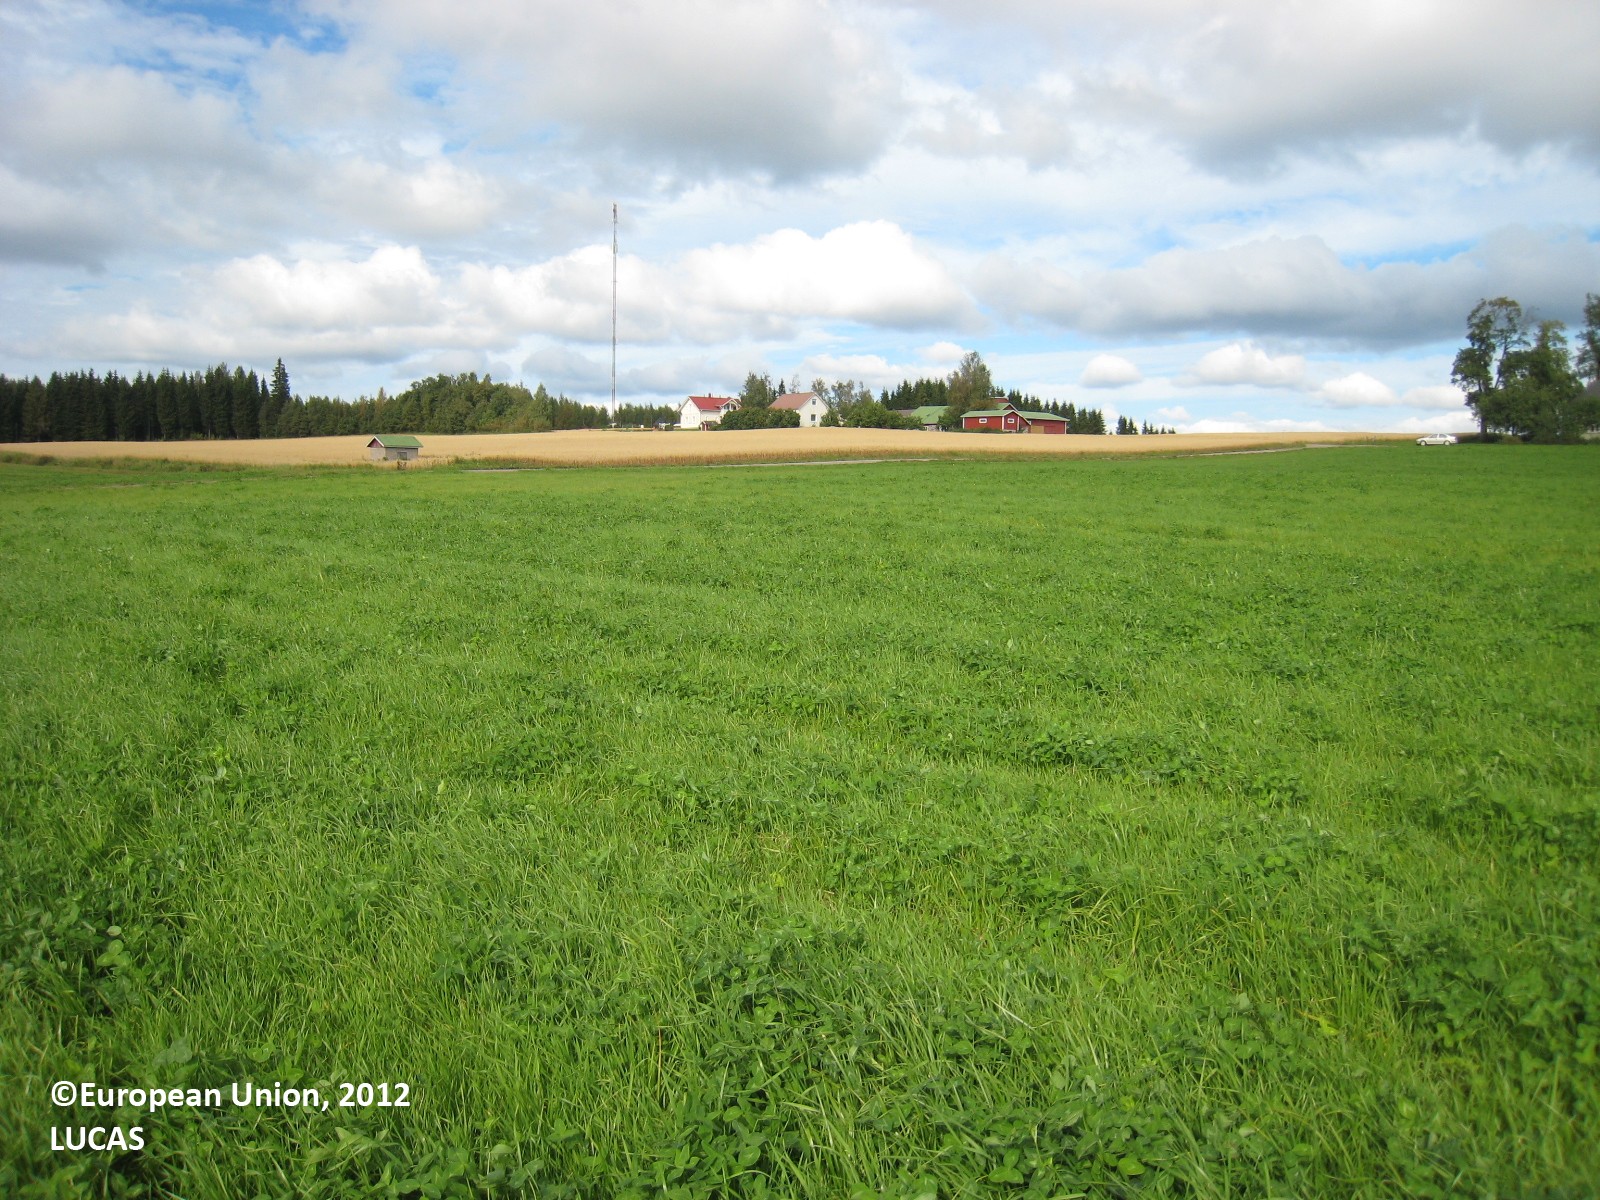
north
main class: Cropland
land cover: Temporary grasslands
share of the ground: > 75 %
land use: Agriculture (excluding fallow land and kitchen gardens)
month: August
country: FI
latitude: 62.2111
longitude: 27.2951
